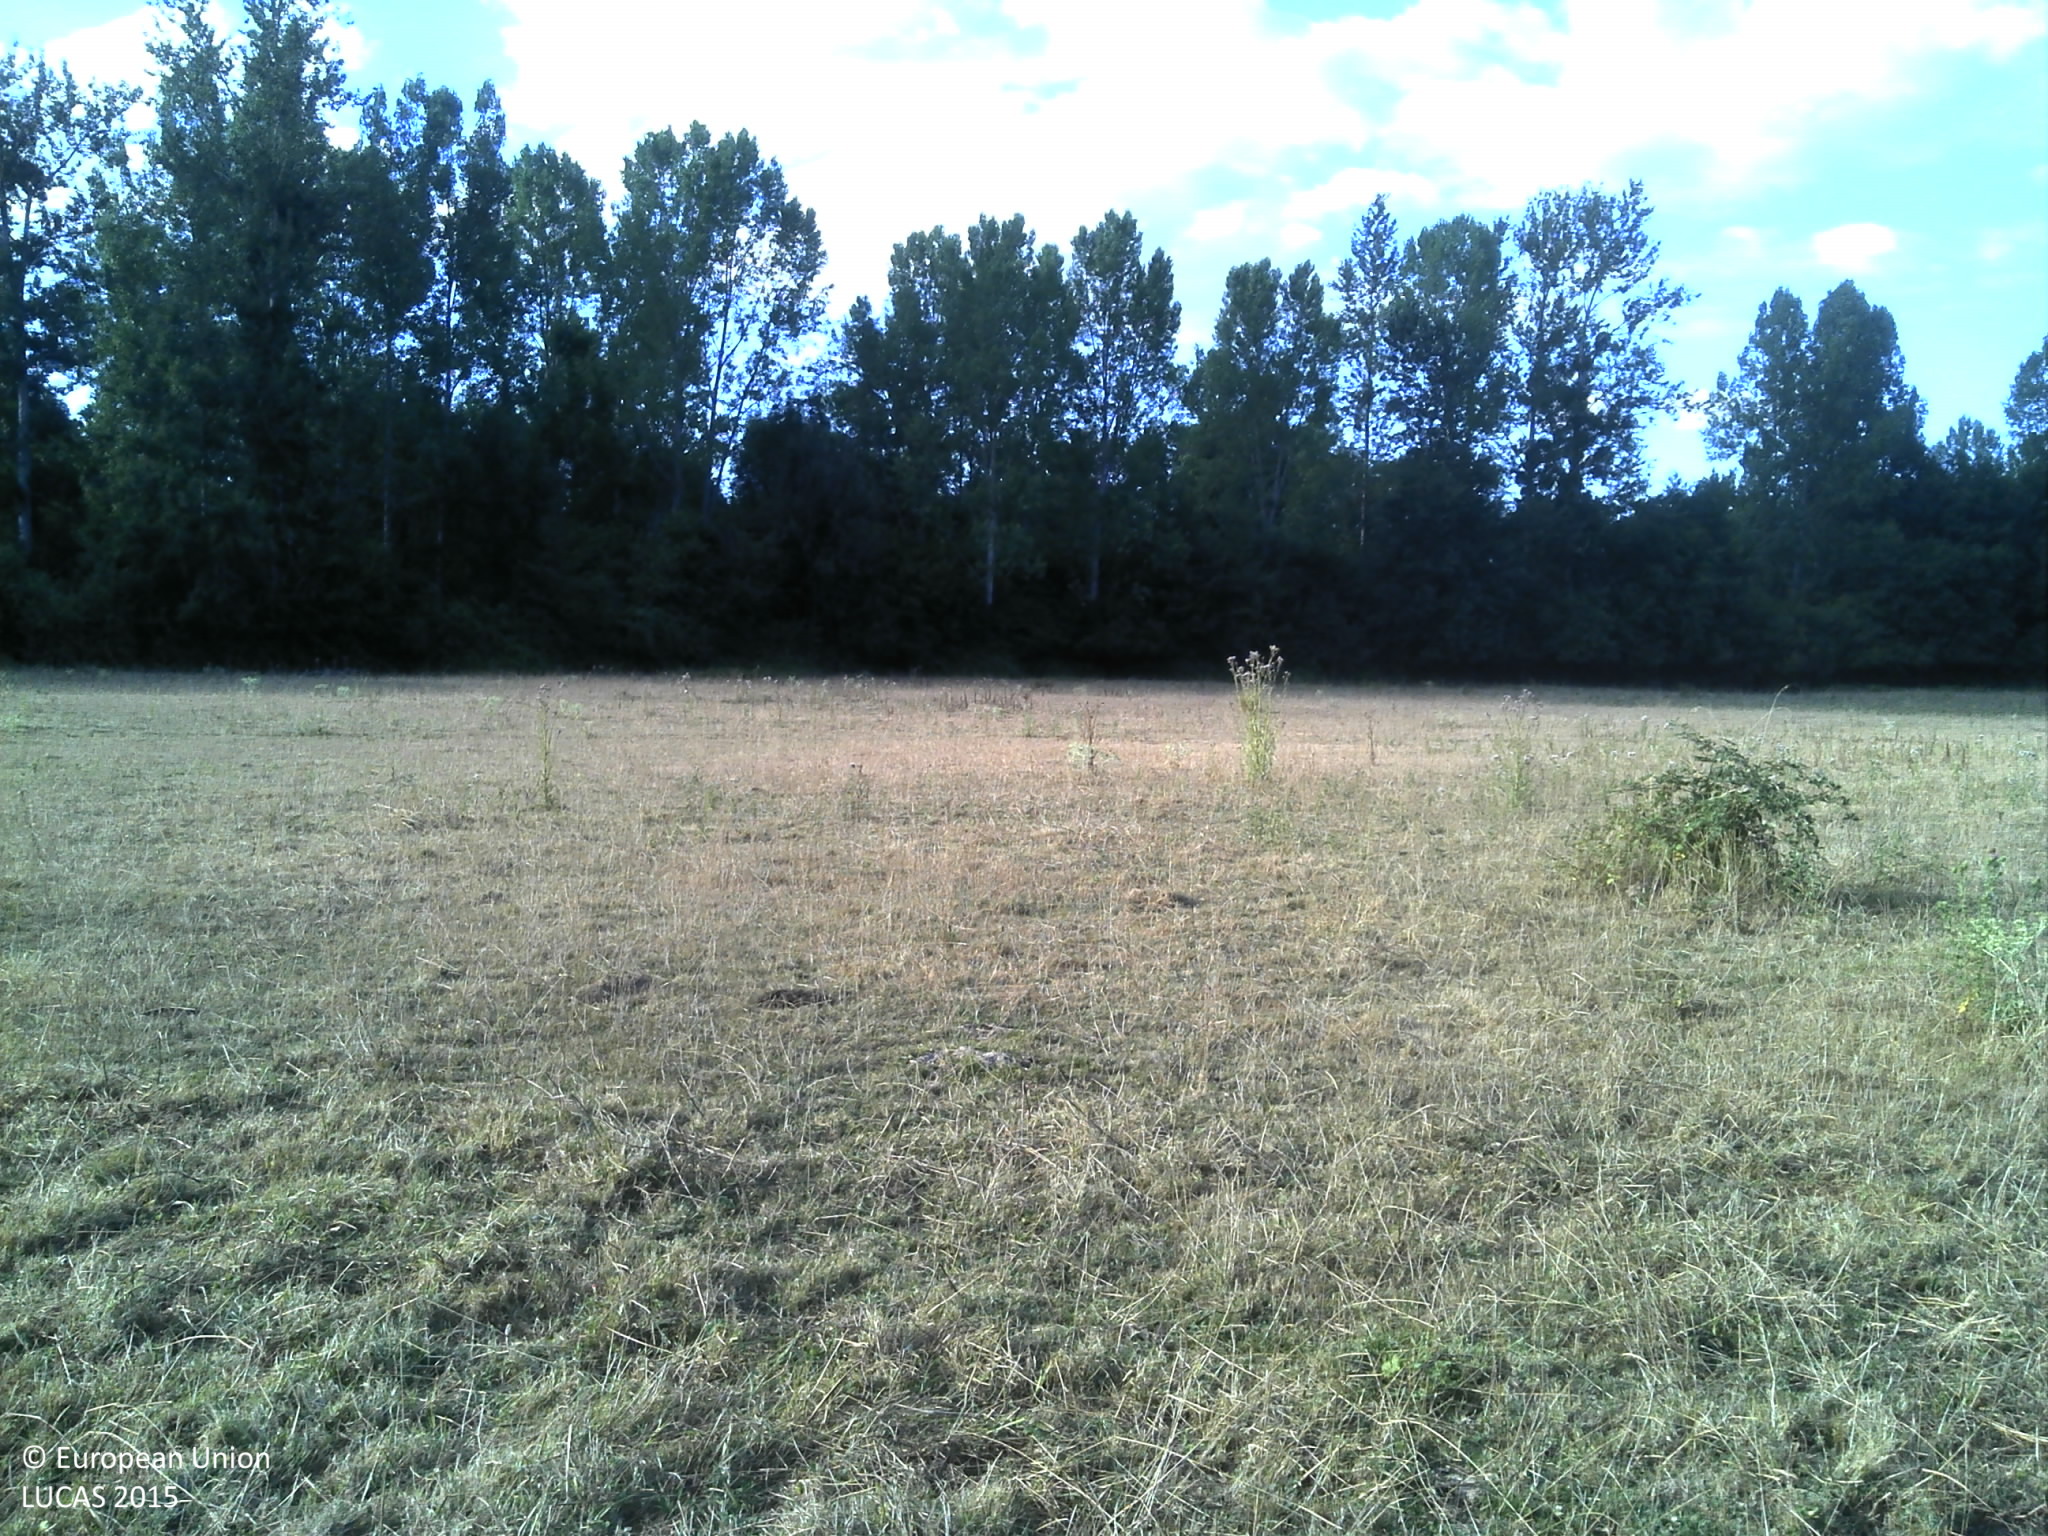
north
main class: Grassland
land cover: Grassland without tree/shrub cover
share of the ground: > 75 %
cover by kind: herbaceous plants 100 %
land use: Agriculture (excluding fallow land and kitchen gardens)
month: July
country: FR
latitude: 45.8282
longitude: 4.1195
